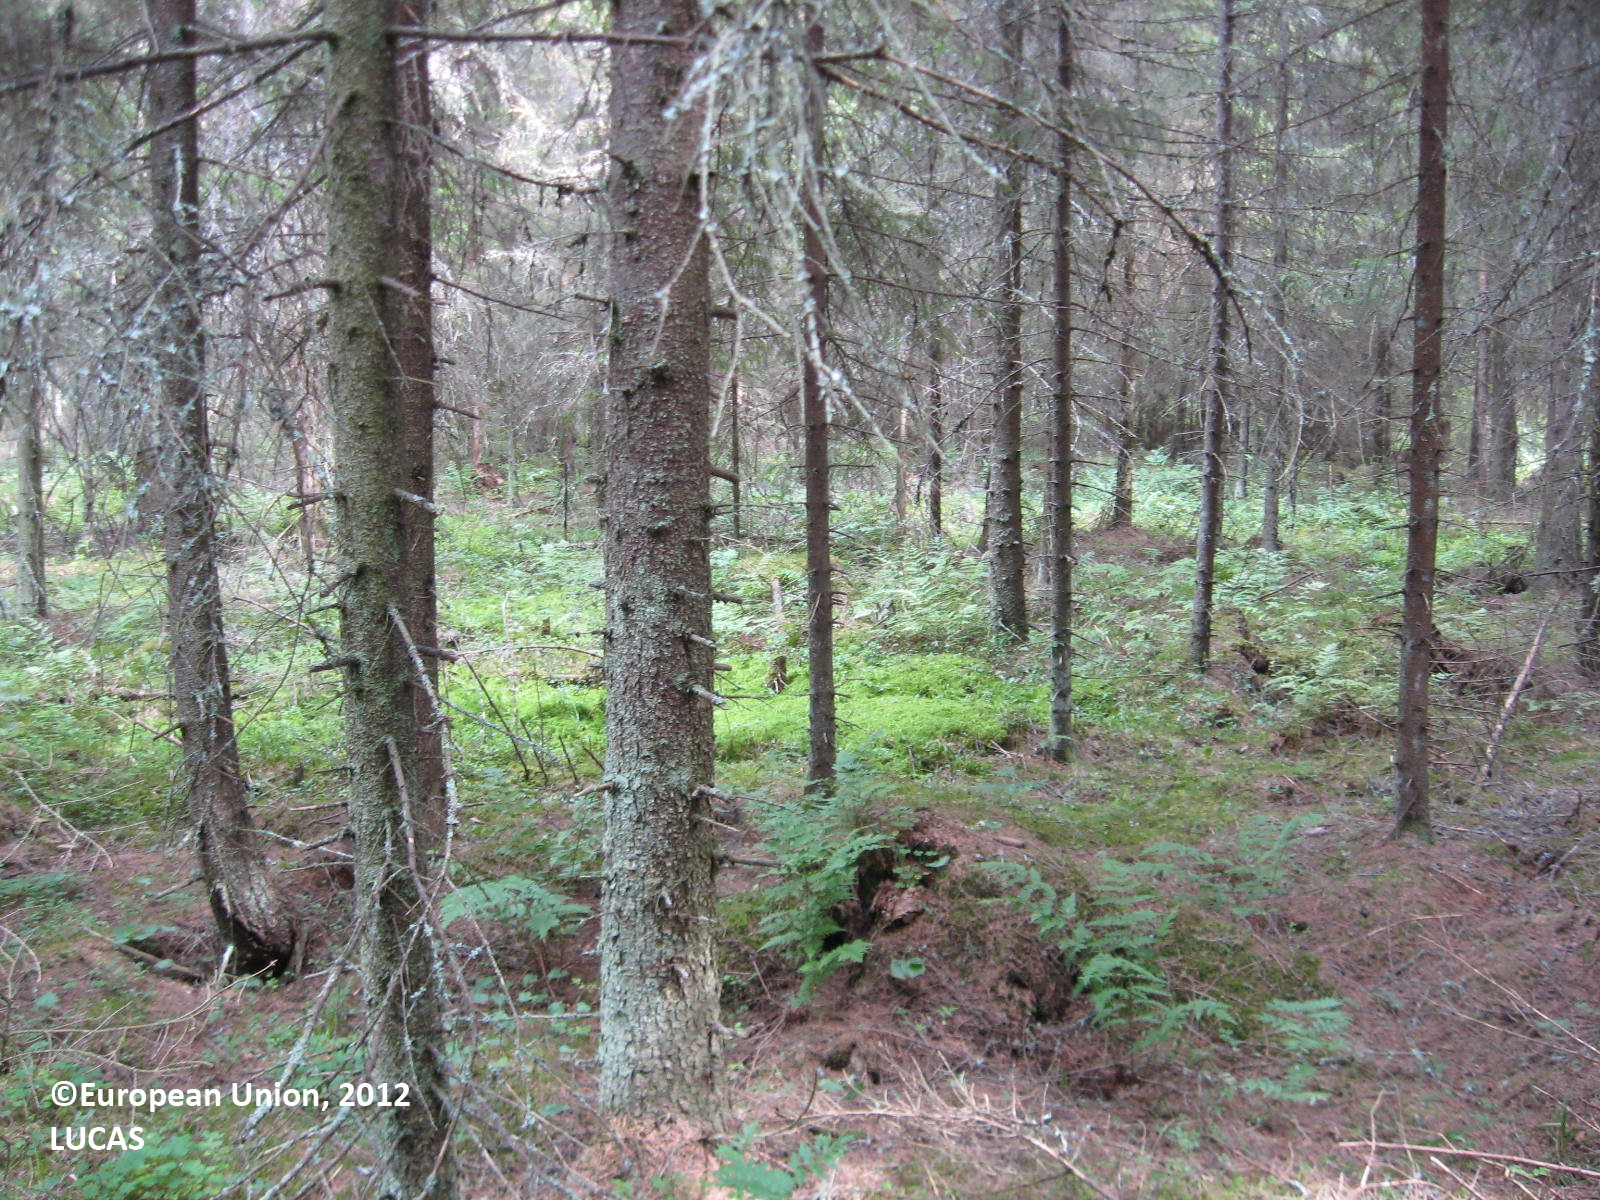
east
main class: Woodland
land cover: Spruce dominated coniferous woodland
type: boreal forest
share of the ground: > 75 %
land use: Forestry
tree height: > 5 m
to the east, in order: Spruce dominated coniferous woodland; Ditches and canals; Tracks; Spruce dominated coniferous woodland; Ditches and canals; Spruce dominated coniferous woodland
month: July
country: FI
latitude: 62.4297
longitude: 21.4505
